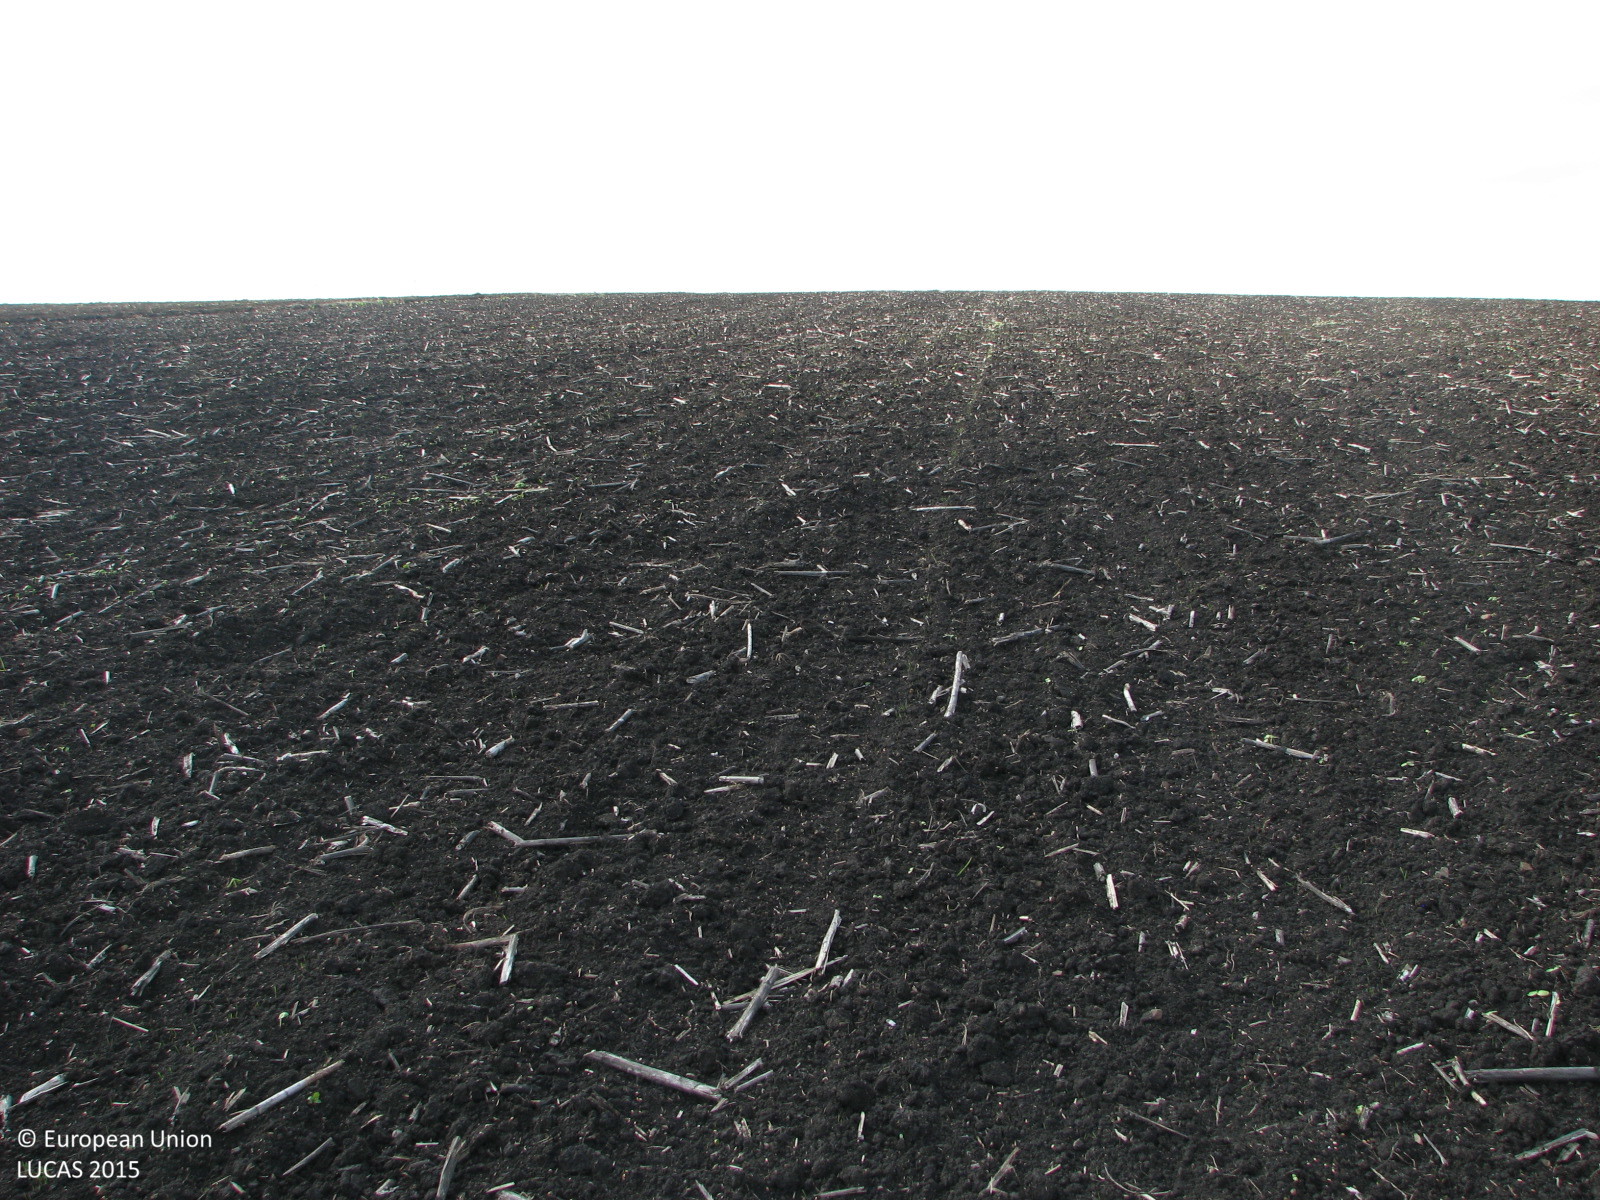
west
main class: Cropland
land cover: Common wheat
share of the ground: < 10 %
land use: Agriculture (excluding fallow land and kitchen gardens)
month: November
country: BG
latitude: 42.4993
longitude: 26.8569
